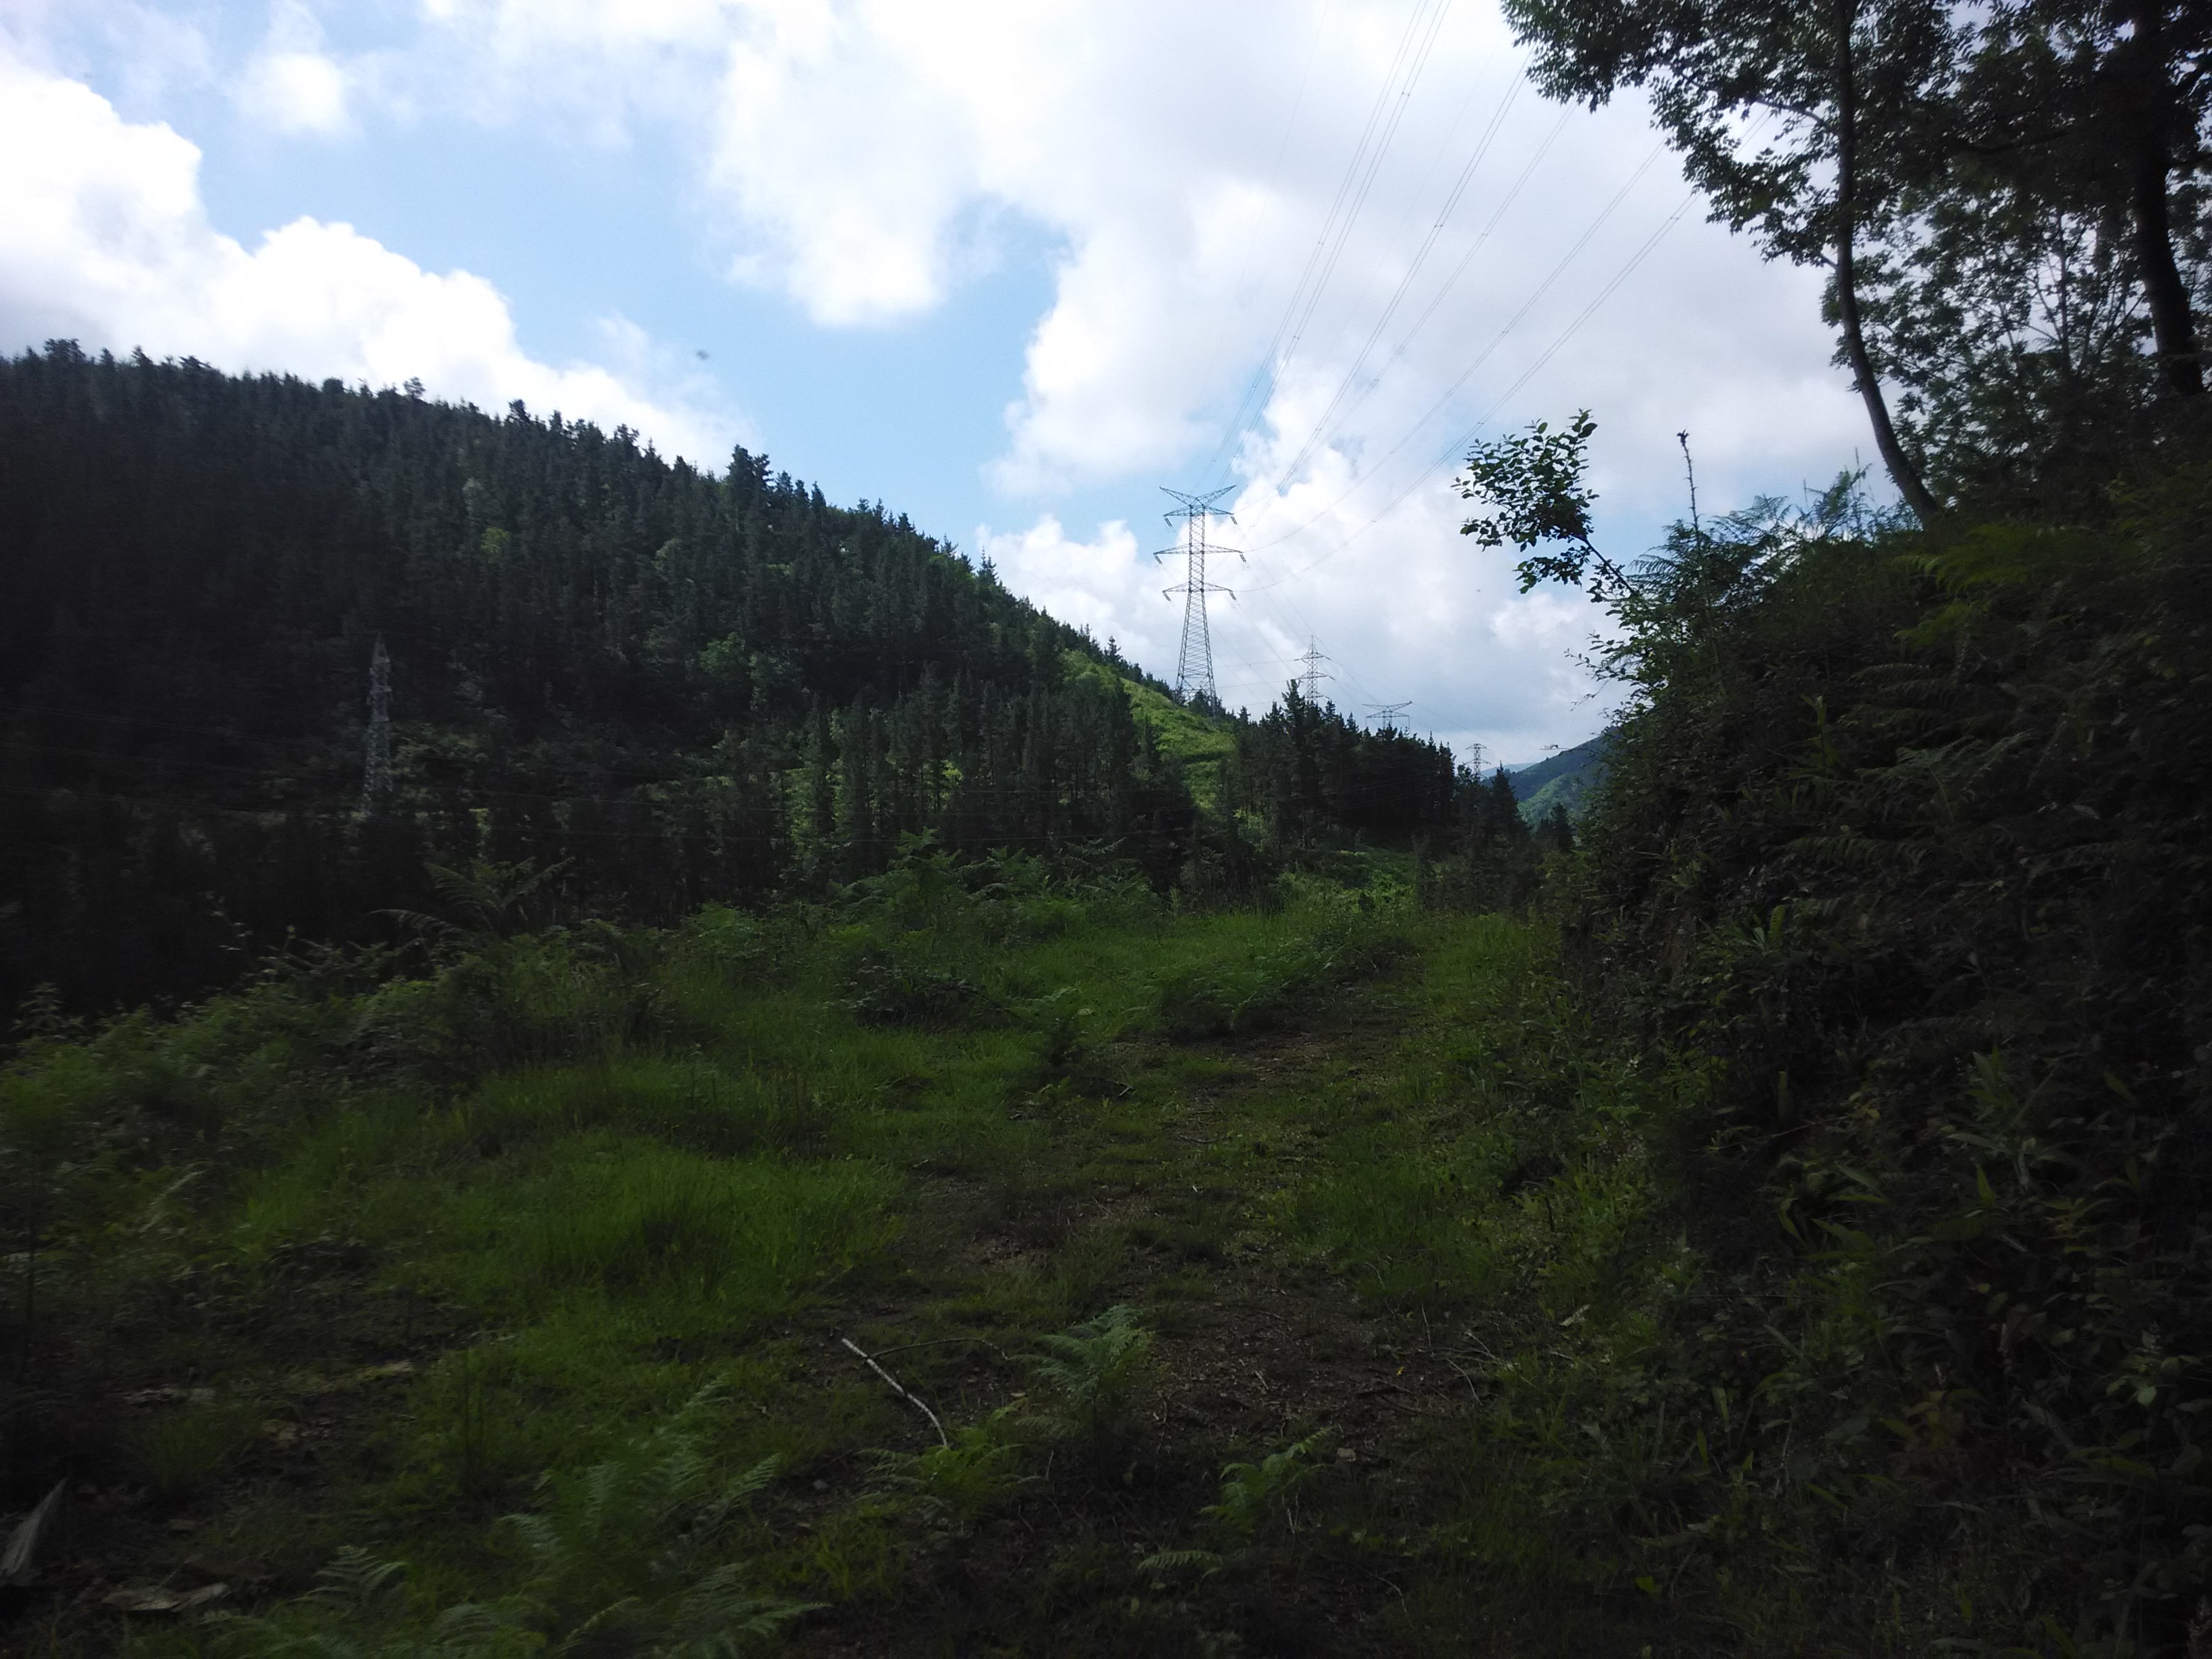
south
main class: Grassland
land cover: Grassland without tree/shrub cover
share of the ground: > 75 %
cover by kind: herbaceous plants 100 %
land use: Agriculture (excluding fallow land and kitchen gardens)
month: June
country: ES
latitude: 43.2208
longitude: -2.2496
